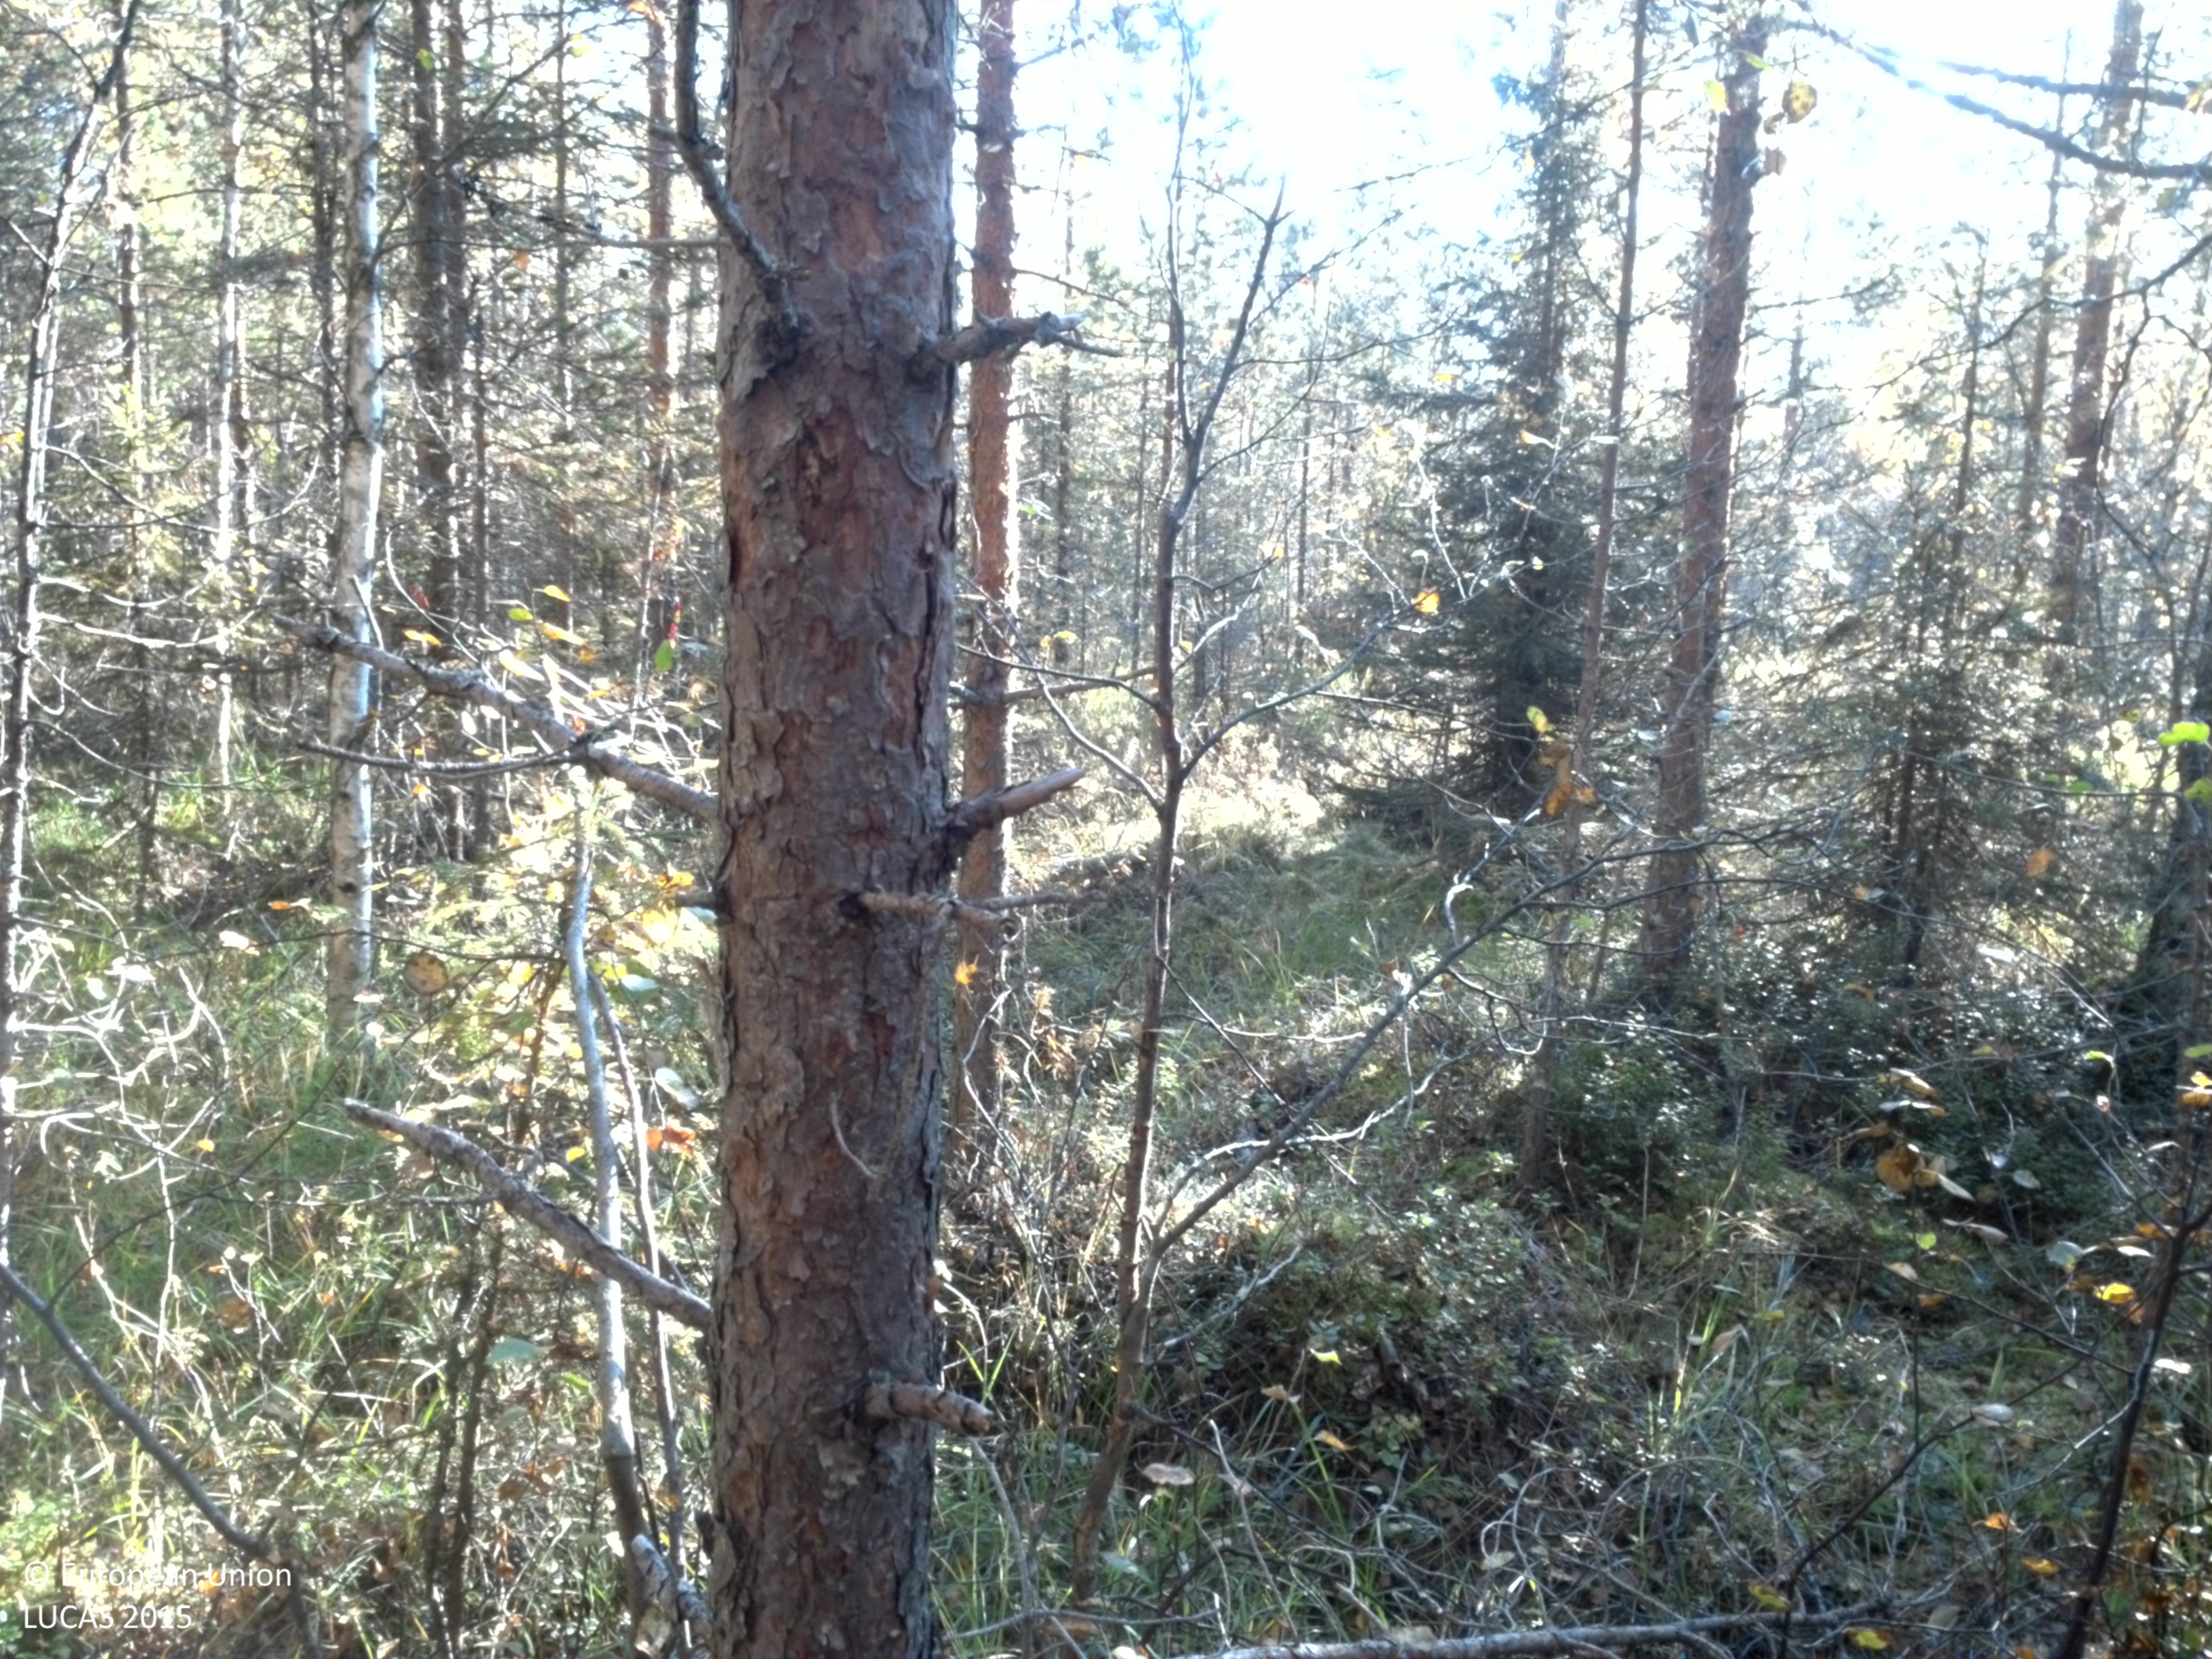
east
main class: Woodland
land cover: Pine dominated mixed woodland
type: boreal forest
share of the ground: 50 - 75 %
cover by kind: coniferous forest trees 35 %, broadleaved forest trees 30 %, shrubs 20 %, unconsolidated bare surface 10 %, lichens and mosses 5 %
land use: Forestry
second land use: Amenities, museums, leisure
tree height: < 5 m
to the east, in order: Pine dominated mixed woodland; Pine dominated coniferous woodland; Pine dominated mixed woodland; Ditches and canals; Pine dominated coniferous woodland
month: September
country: SE
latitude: 65.5640
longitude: 22.3523
